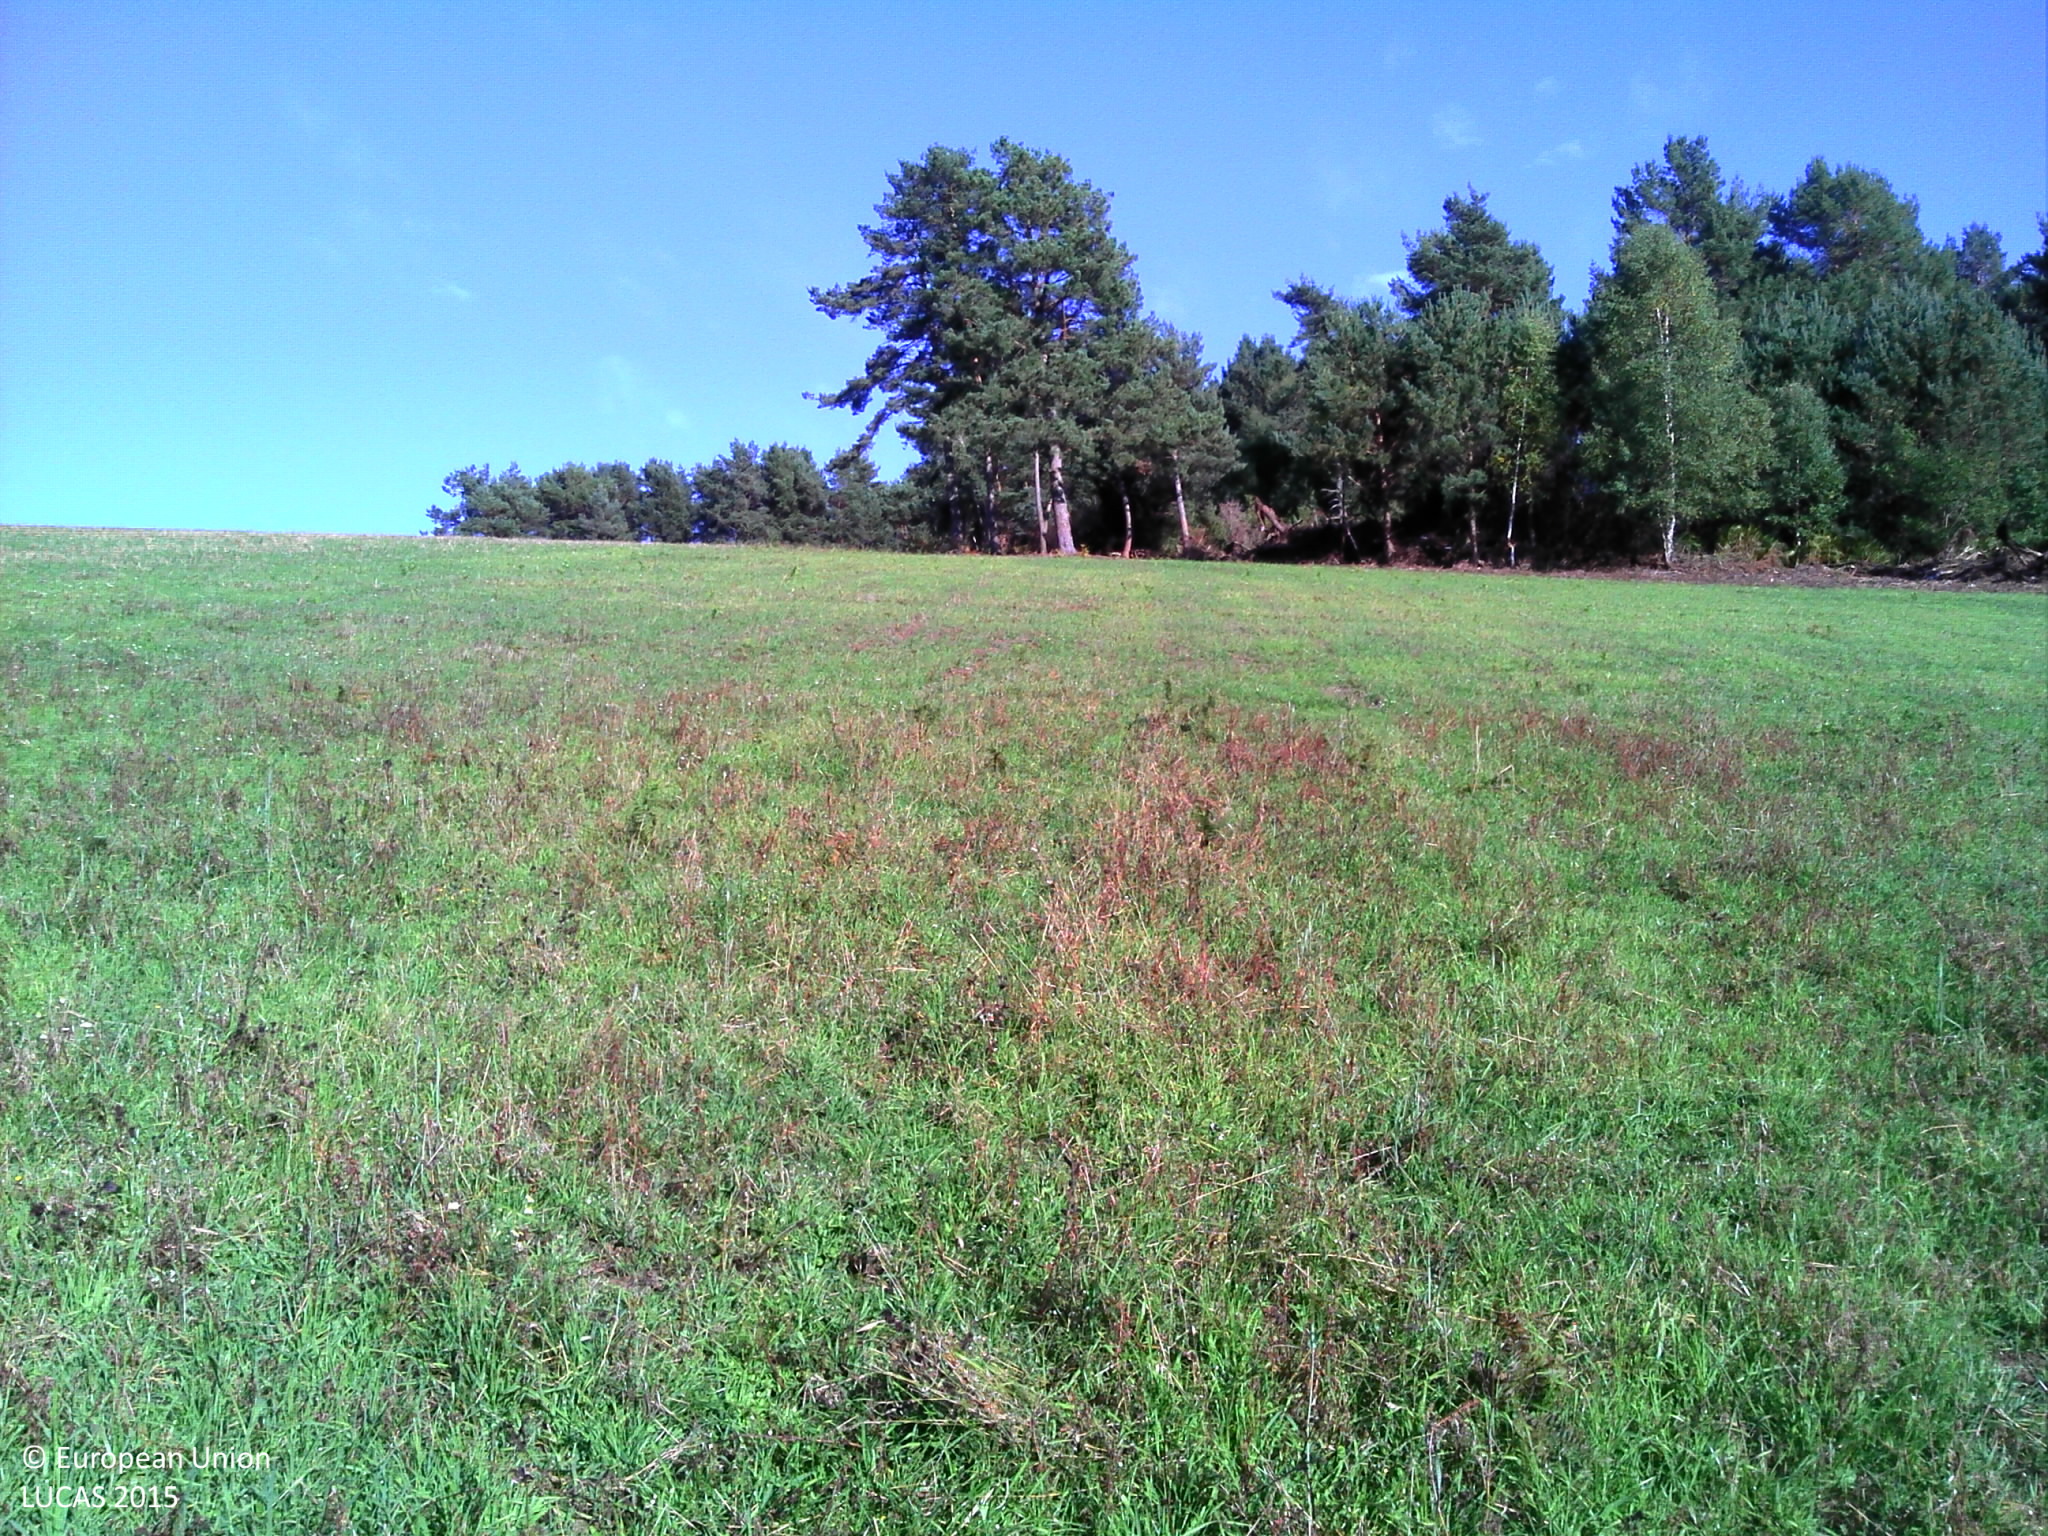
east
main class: Grassland
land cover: Grassland without tree/shrub cover
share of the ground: > 75 %
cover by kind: herbaceous plants 100 %
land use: Agriculture (excluding fallow land and kitchen gardens)
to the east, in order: Grassland without tree/shrub cover; Pine dominated coniferous woodland; Other bare soil; Fences; Pine dominated coniferous woodland; Fences; Grassland without tree/shrub cover; Fences; Tracks; Grass margins; Fences; Pine dominated coniferous woodland
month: September
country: FR
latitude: 45.8014
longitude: 2.8063
